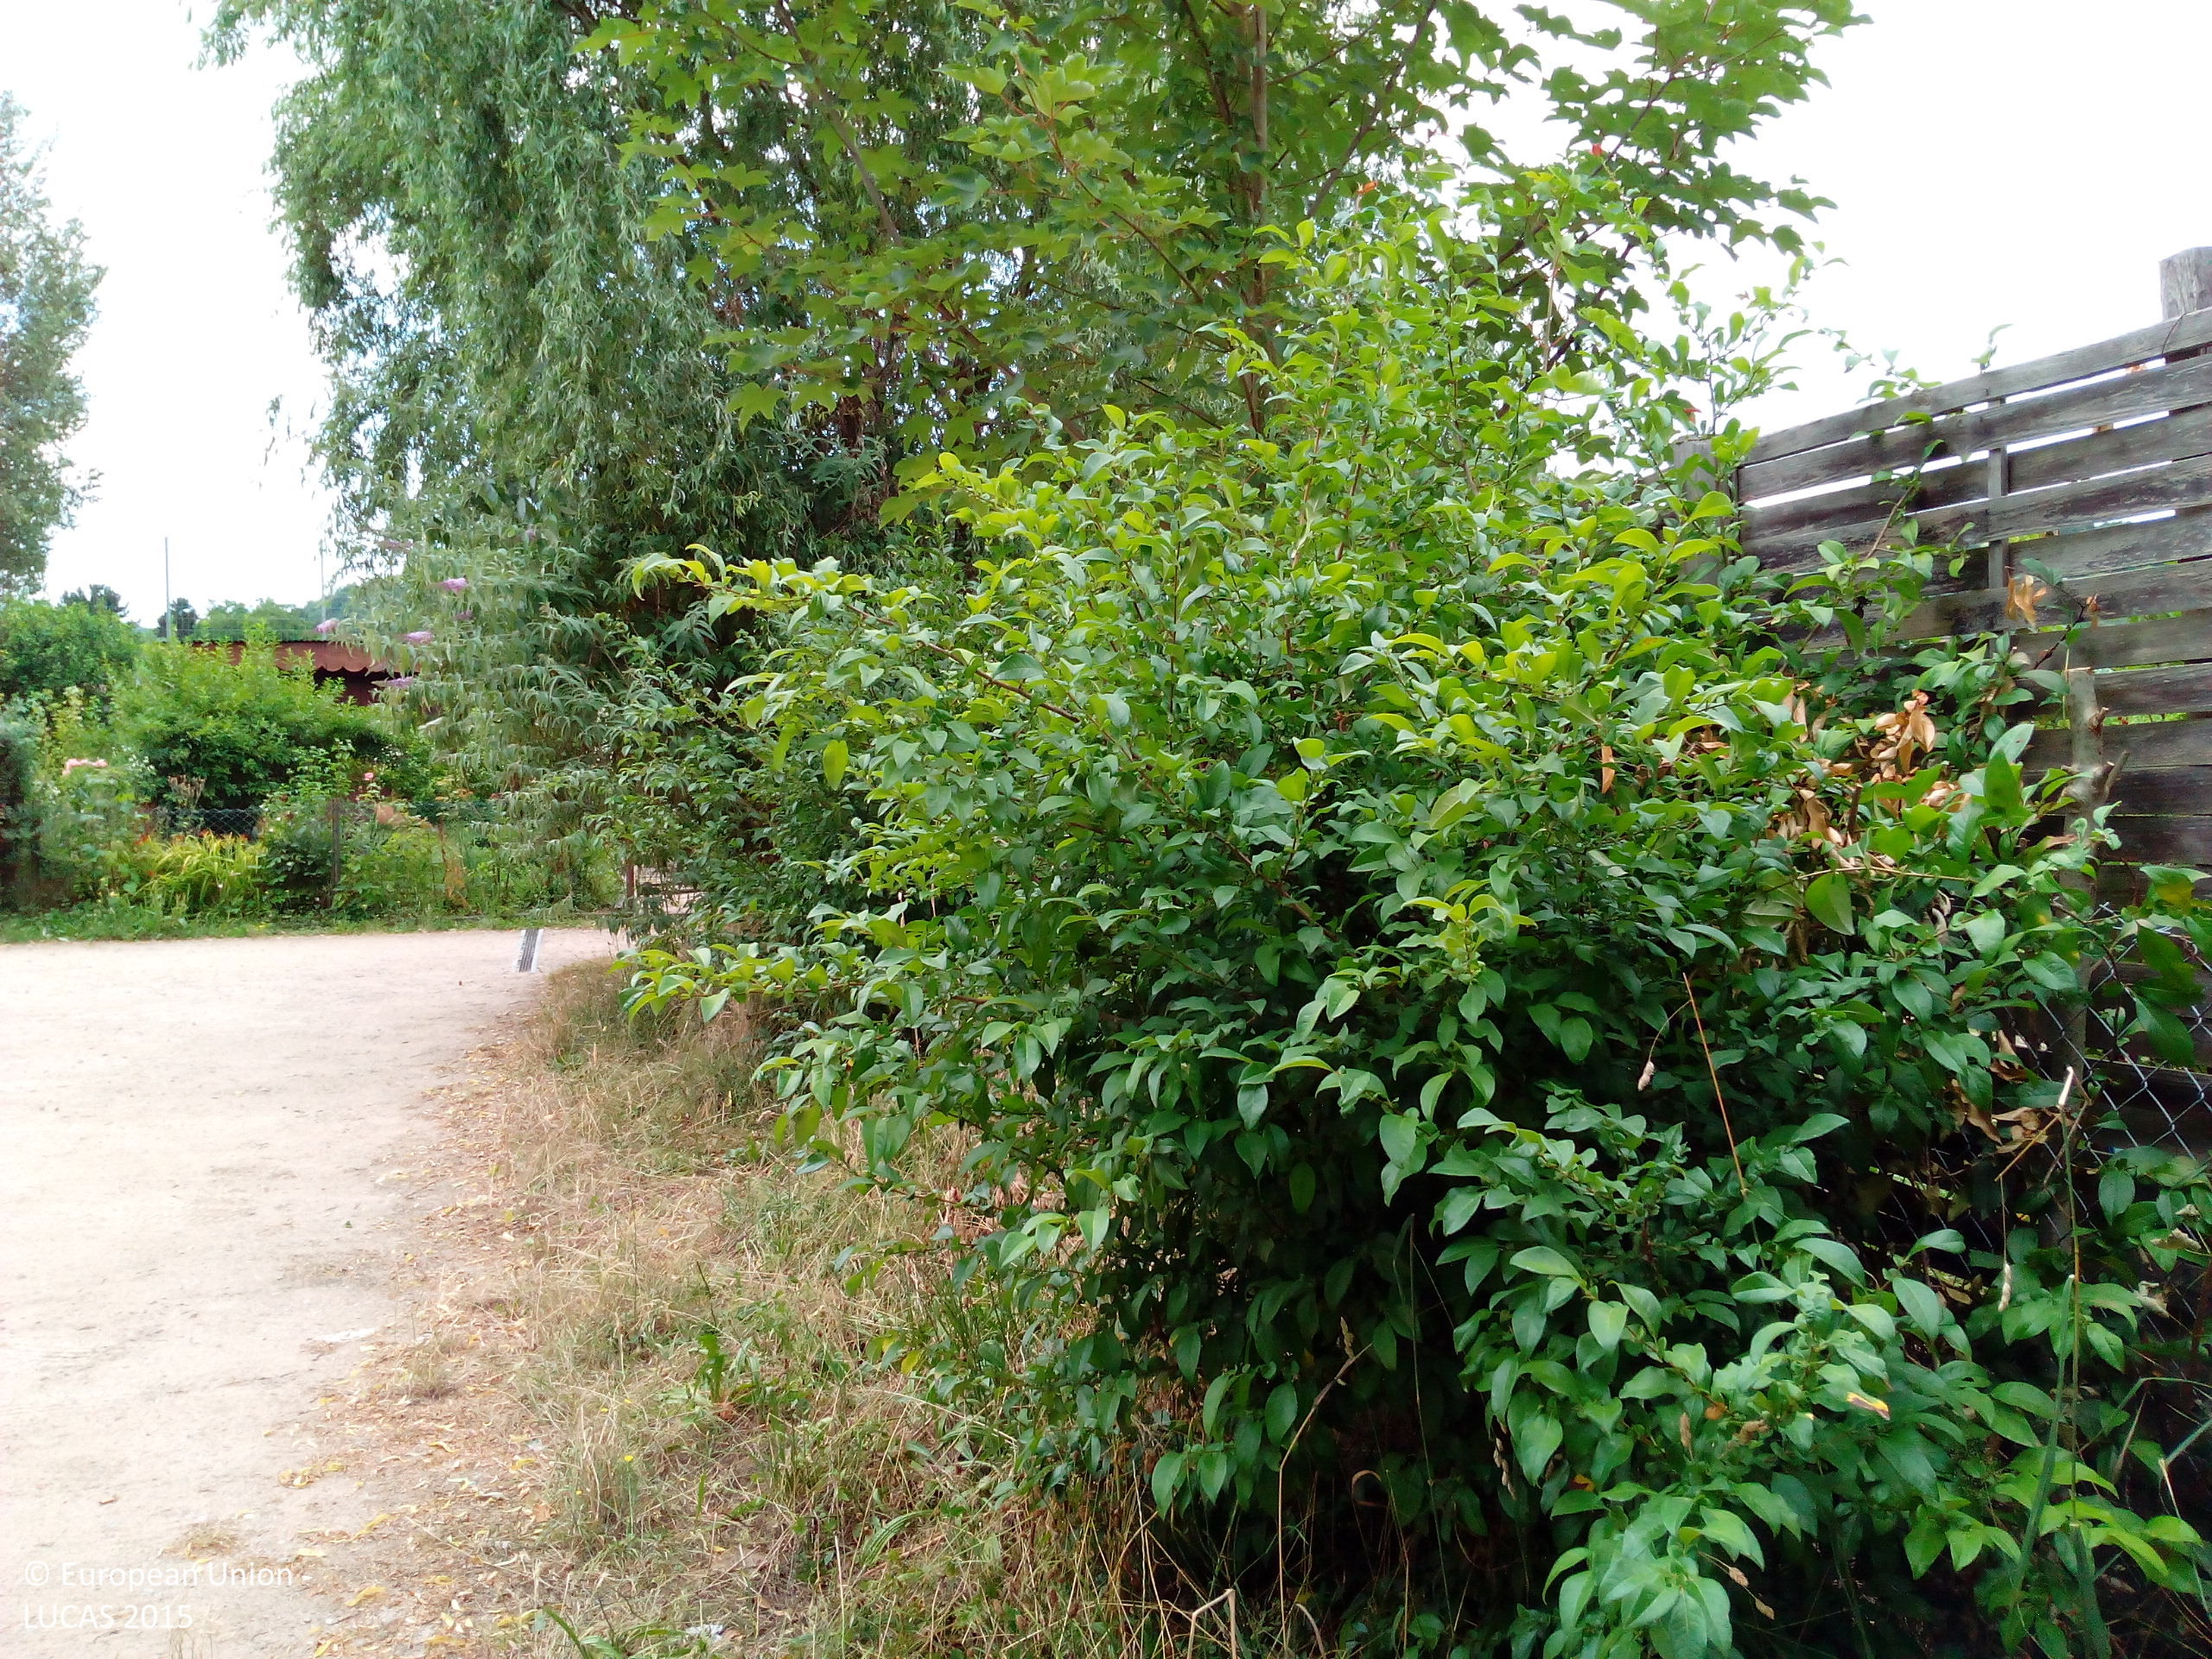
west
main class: Grassland
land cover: Grassland without tree/shrub cover
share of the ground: > 75 %
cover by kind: herbaceous plants 85 %, unconsolidated bare surface 15 %
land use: Kitchen garden
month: July
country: DE
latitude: 47.6414
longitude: 7.6987
